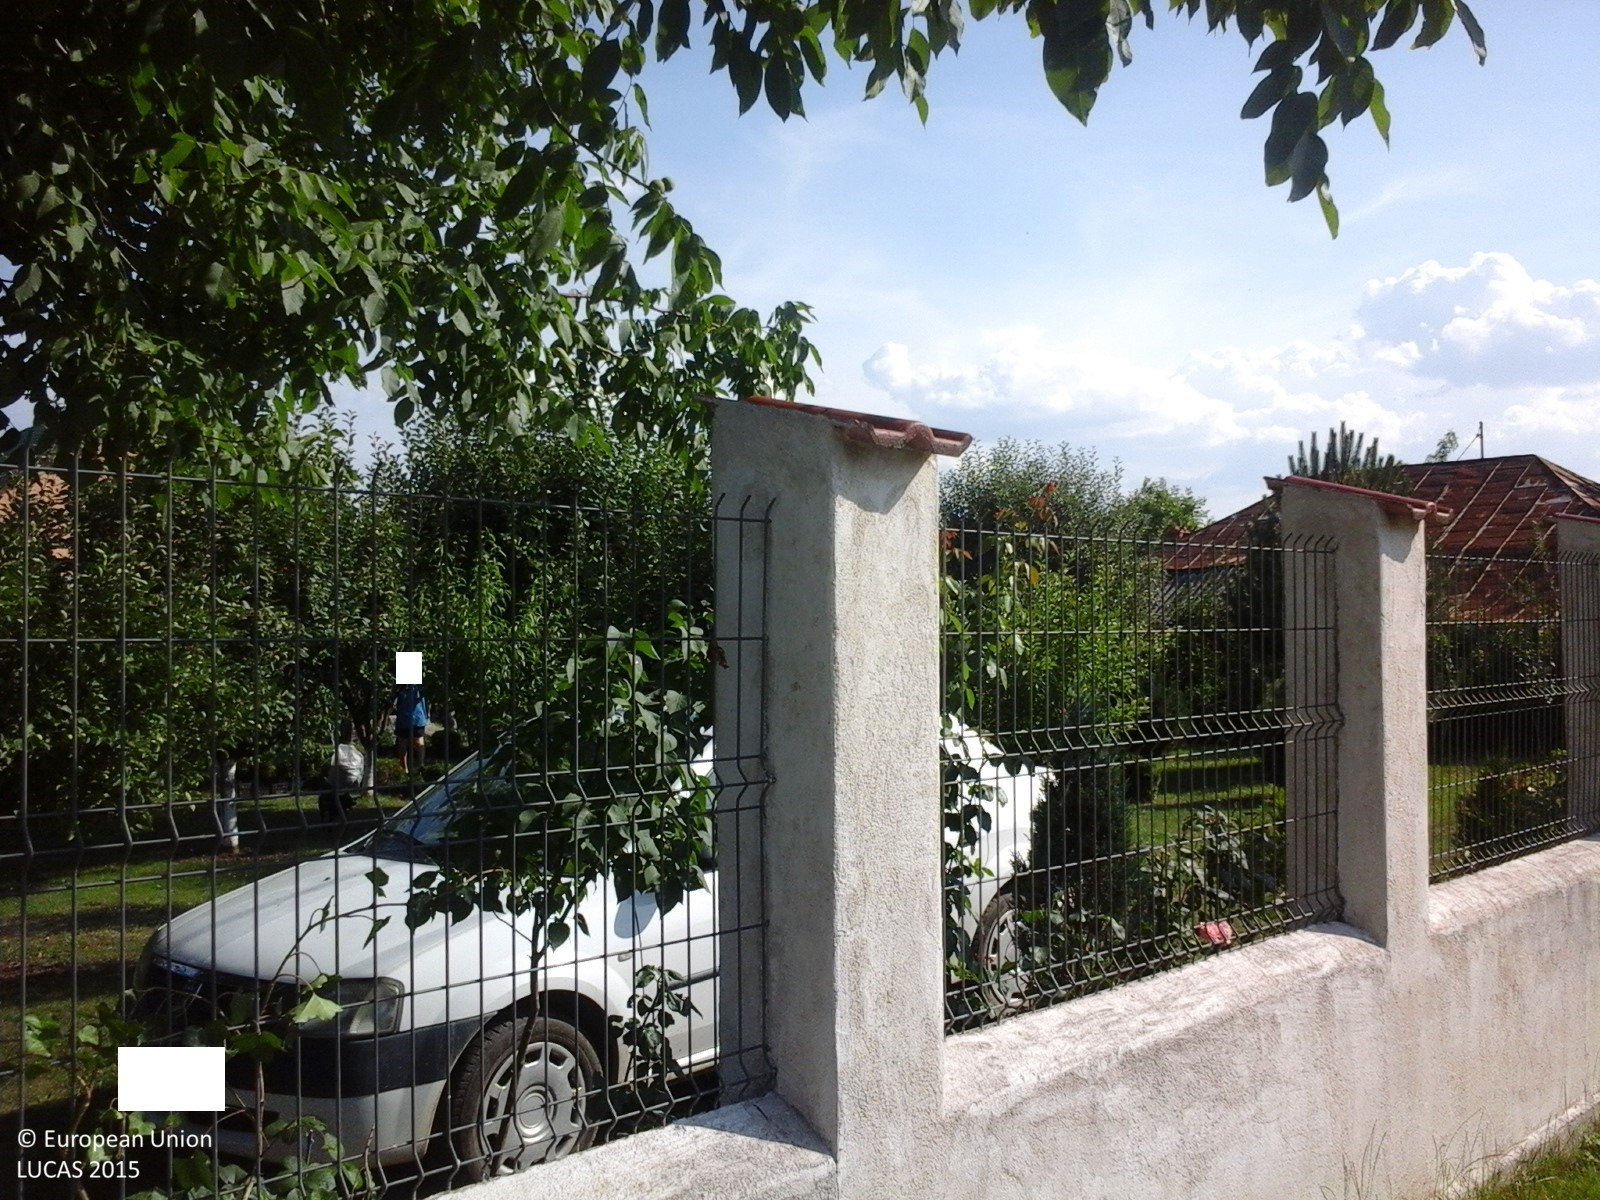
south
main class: Cropland
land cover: Apple fruit
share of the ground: 50 - 75 %
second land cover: Grassland without tree/shrub cover
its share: > 75 %
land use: Agriculture (excluding fallow land and kitchen gardens)
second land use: Residential
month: June
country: RO
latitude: 44.6061
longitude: 26.2251
